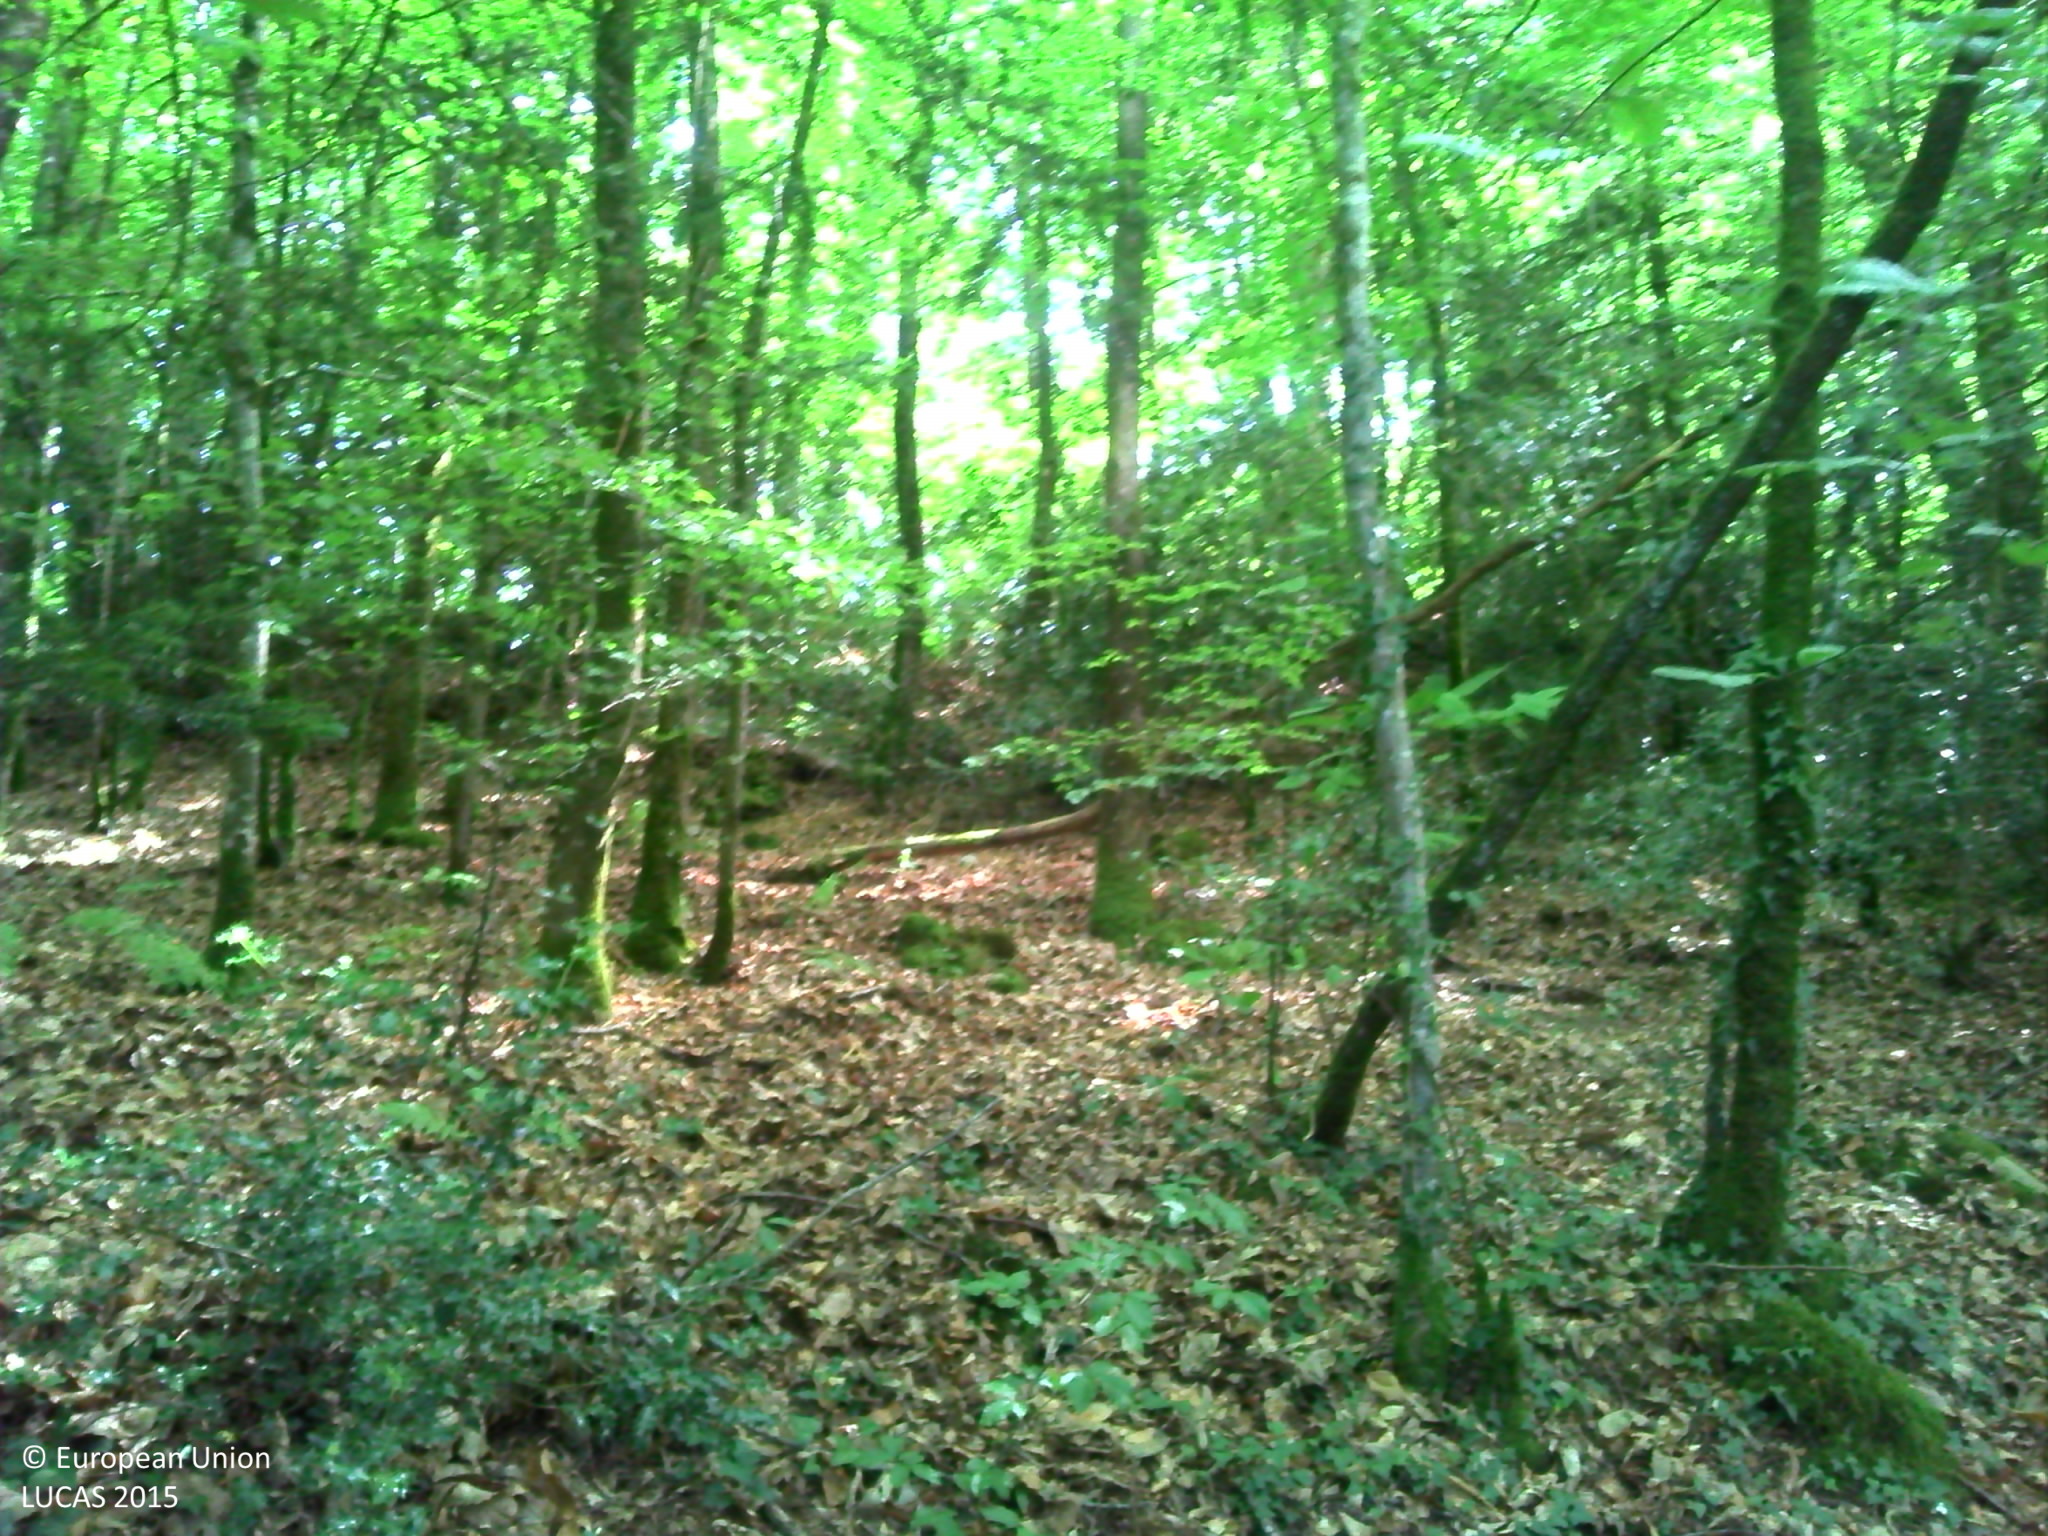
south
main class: Woodland
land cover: Broadleaved woodland
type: acidophilous oak and oak-birch forest
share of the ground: > 75 %
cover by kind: broadleaved forest trees 60 %, coniferous forest trees 10 %, shrubs 10 %, herbaceous plants 10 %, consolidated bare surface 10 %
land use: Forestry
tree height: > 5 m
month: July
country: FR
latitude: 47.9068
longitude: -3.1405
